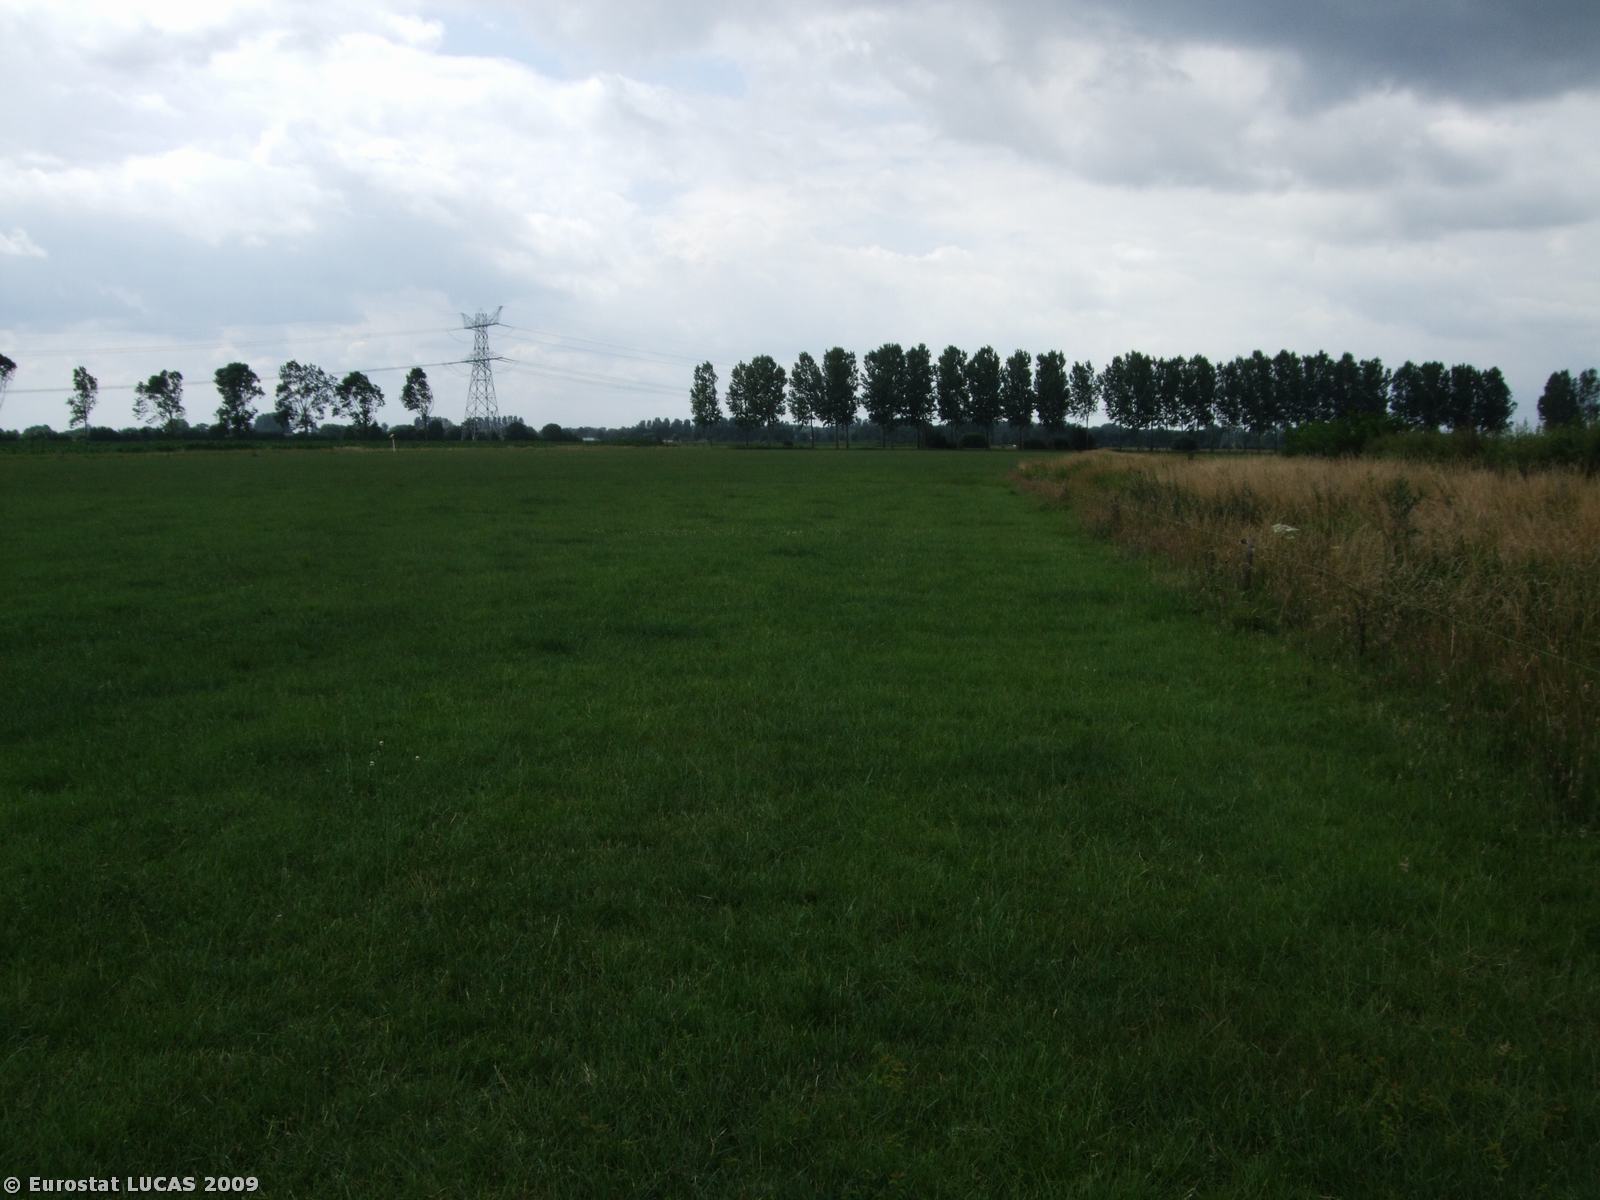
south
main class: Grassland
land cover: Grassland without tree/shrub cover
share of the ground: > 75 %
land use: Agriculture (excluding fallow land and kitchen gardens)
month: July
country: NL
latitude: 51.9719
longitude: 6.1126
